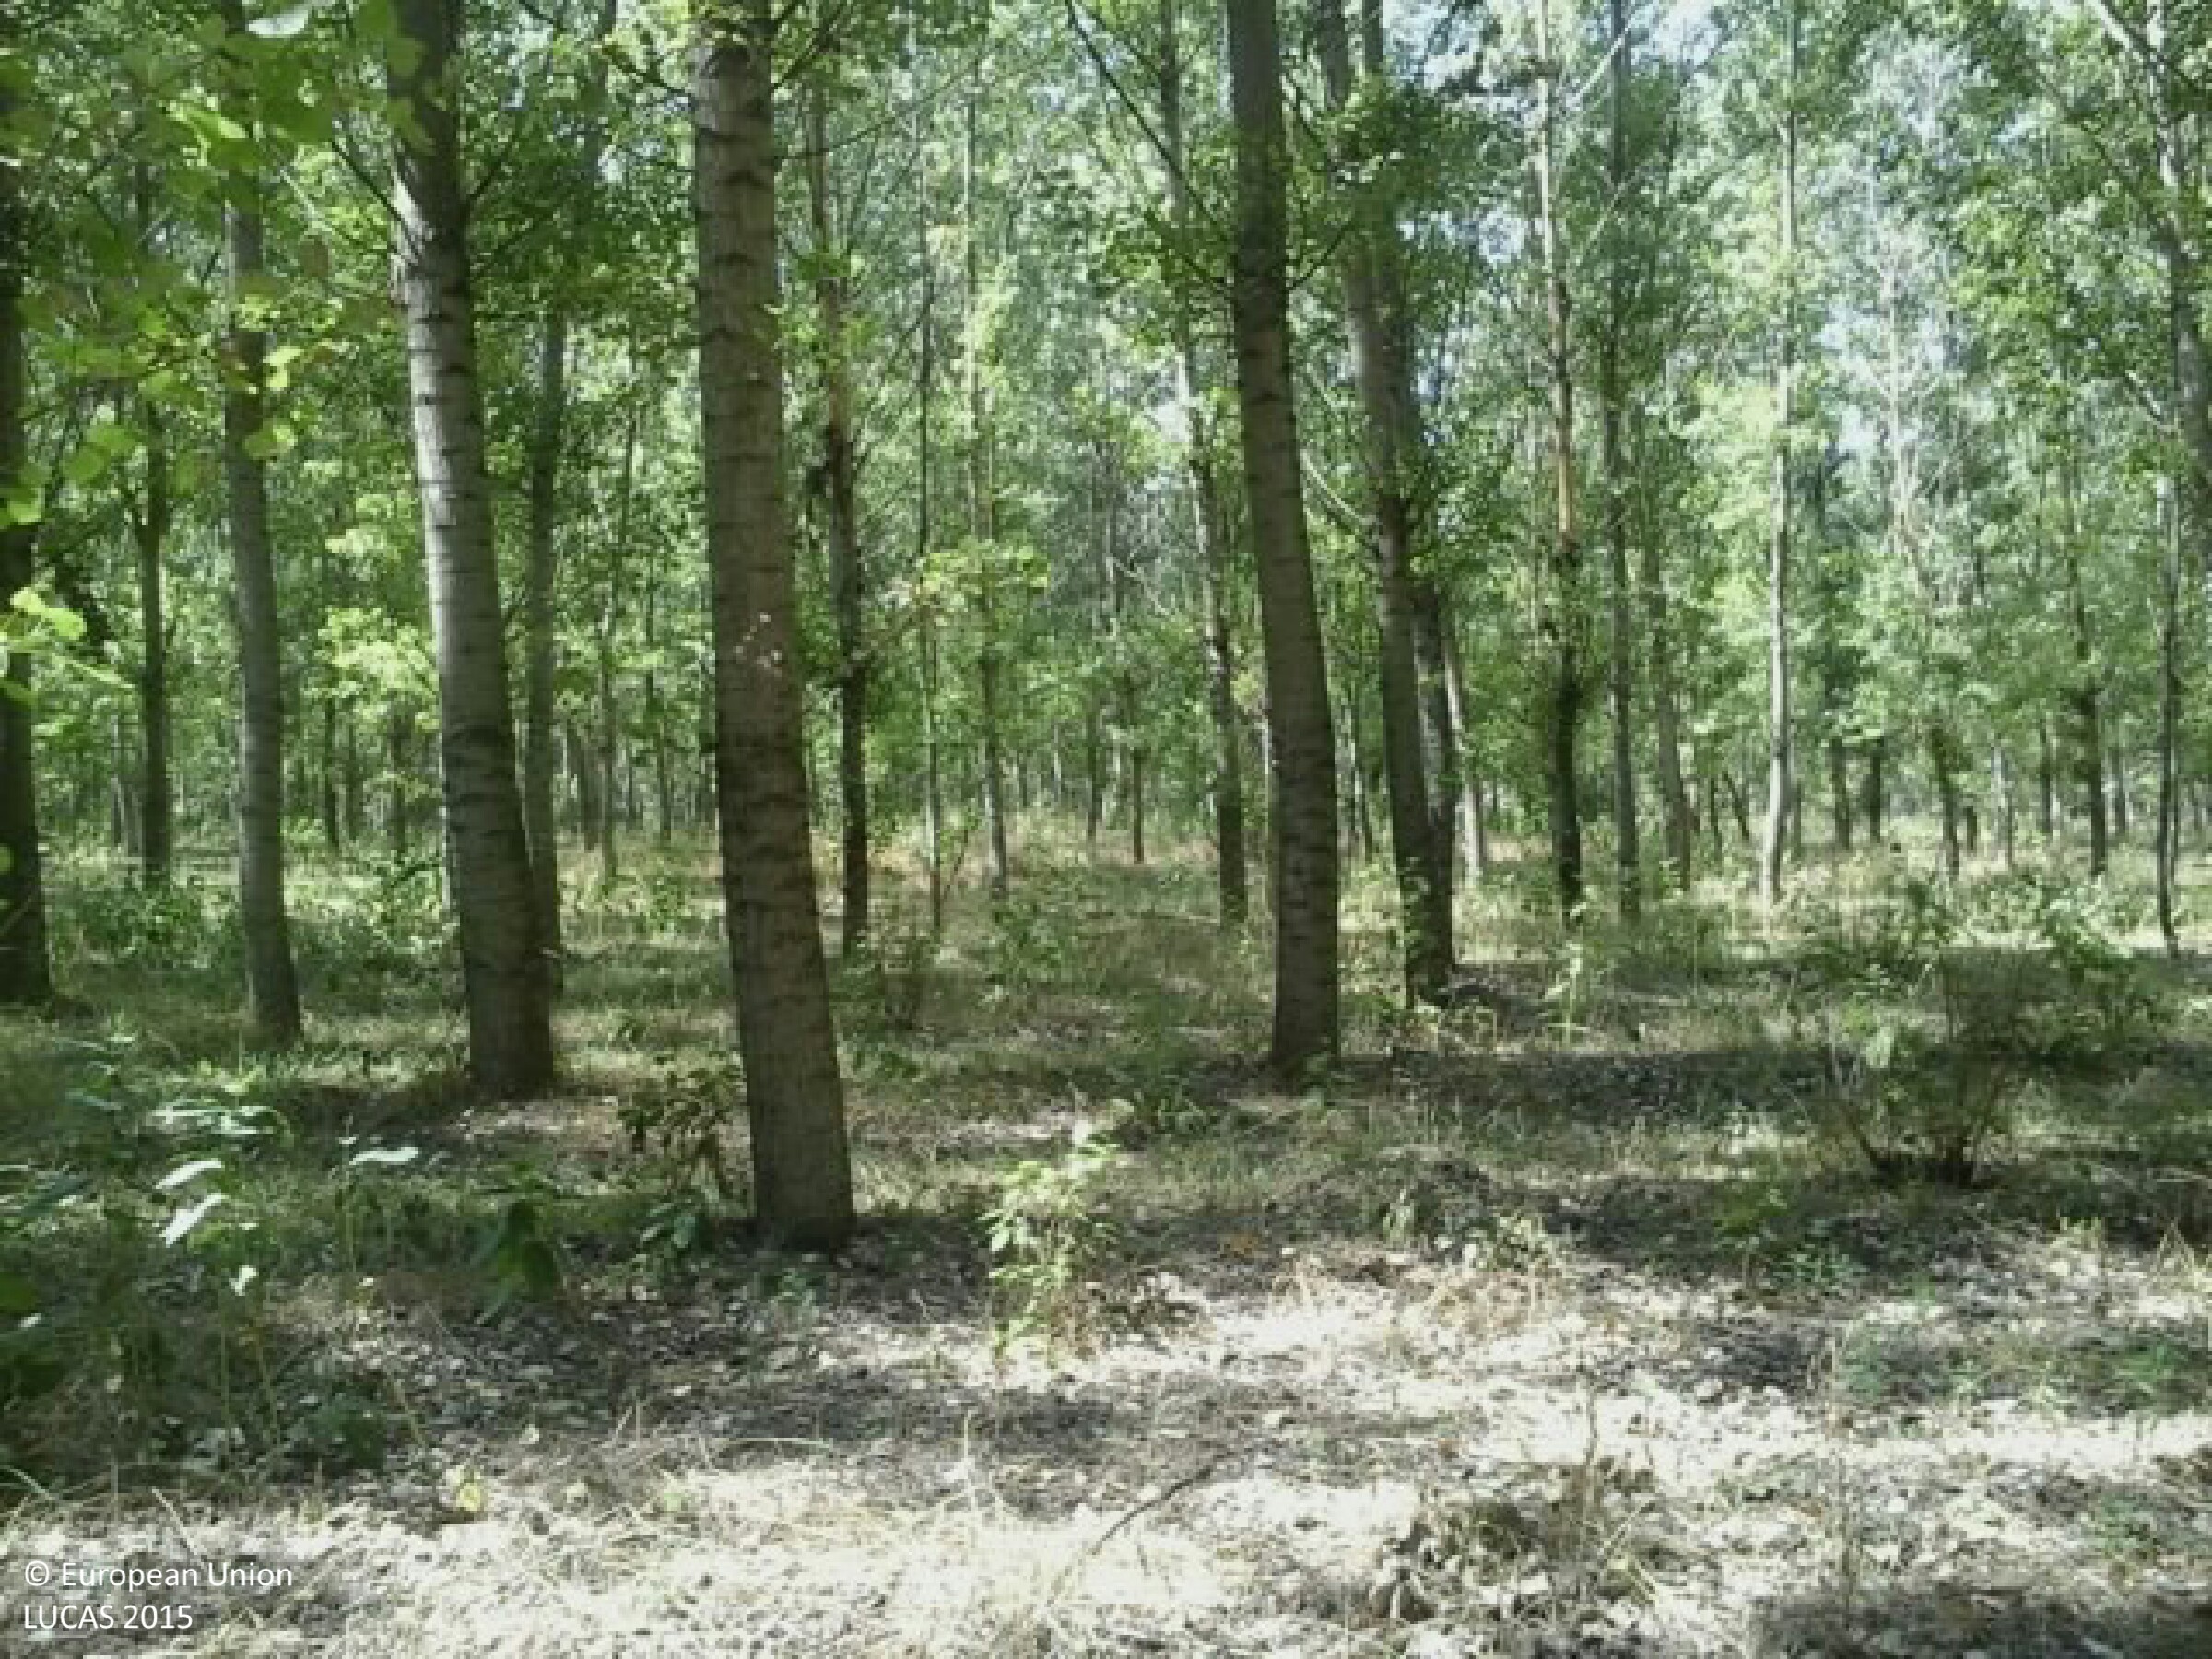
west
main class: Woodland
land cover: Broadleaved woodland
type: mesophytic deciduous forest
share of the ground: > 75 %
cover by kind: broadleaved forest trees 85 %, herbaceous plants 10 %, shrubs 5 %
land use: Forestry
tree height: > 5 m
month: August
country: HU
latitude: 46.9843
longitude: 19.8434
